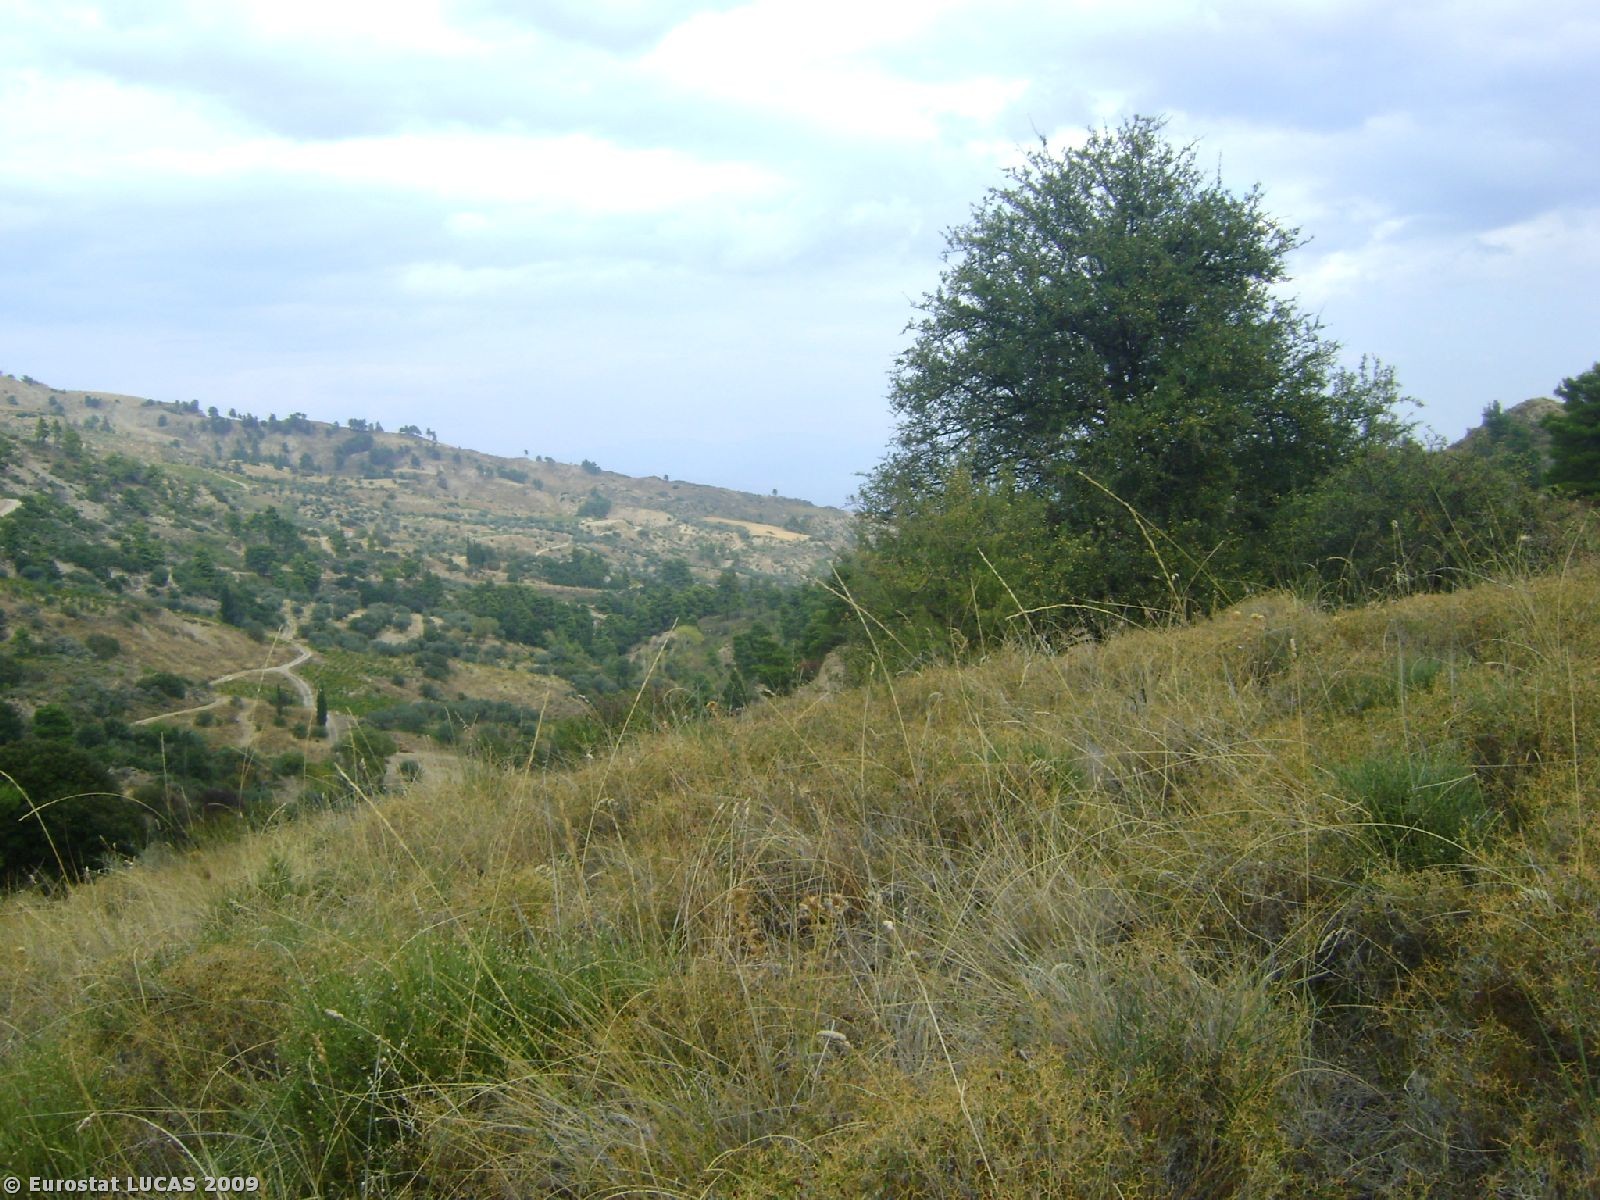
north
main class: Shrubland
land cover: Shrubland with sparse tree cover
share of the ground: > 75 %
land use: Unused
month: October
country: GR
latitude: 38.1181
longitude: 22.2998
